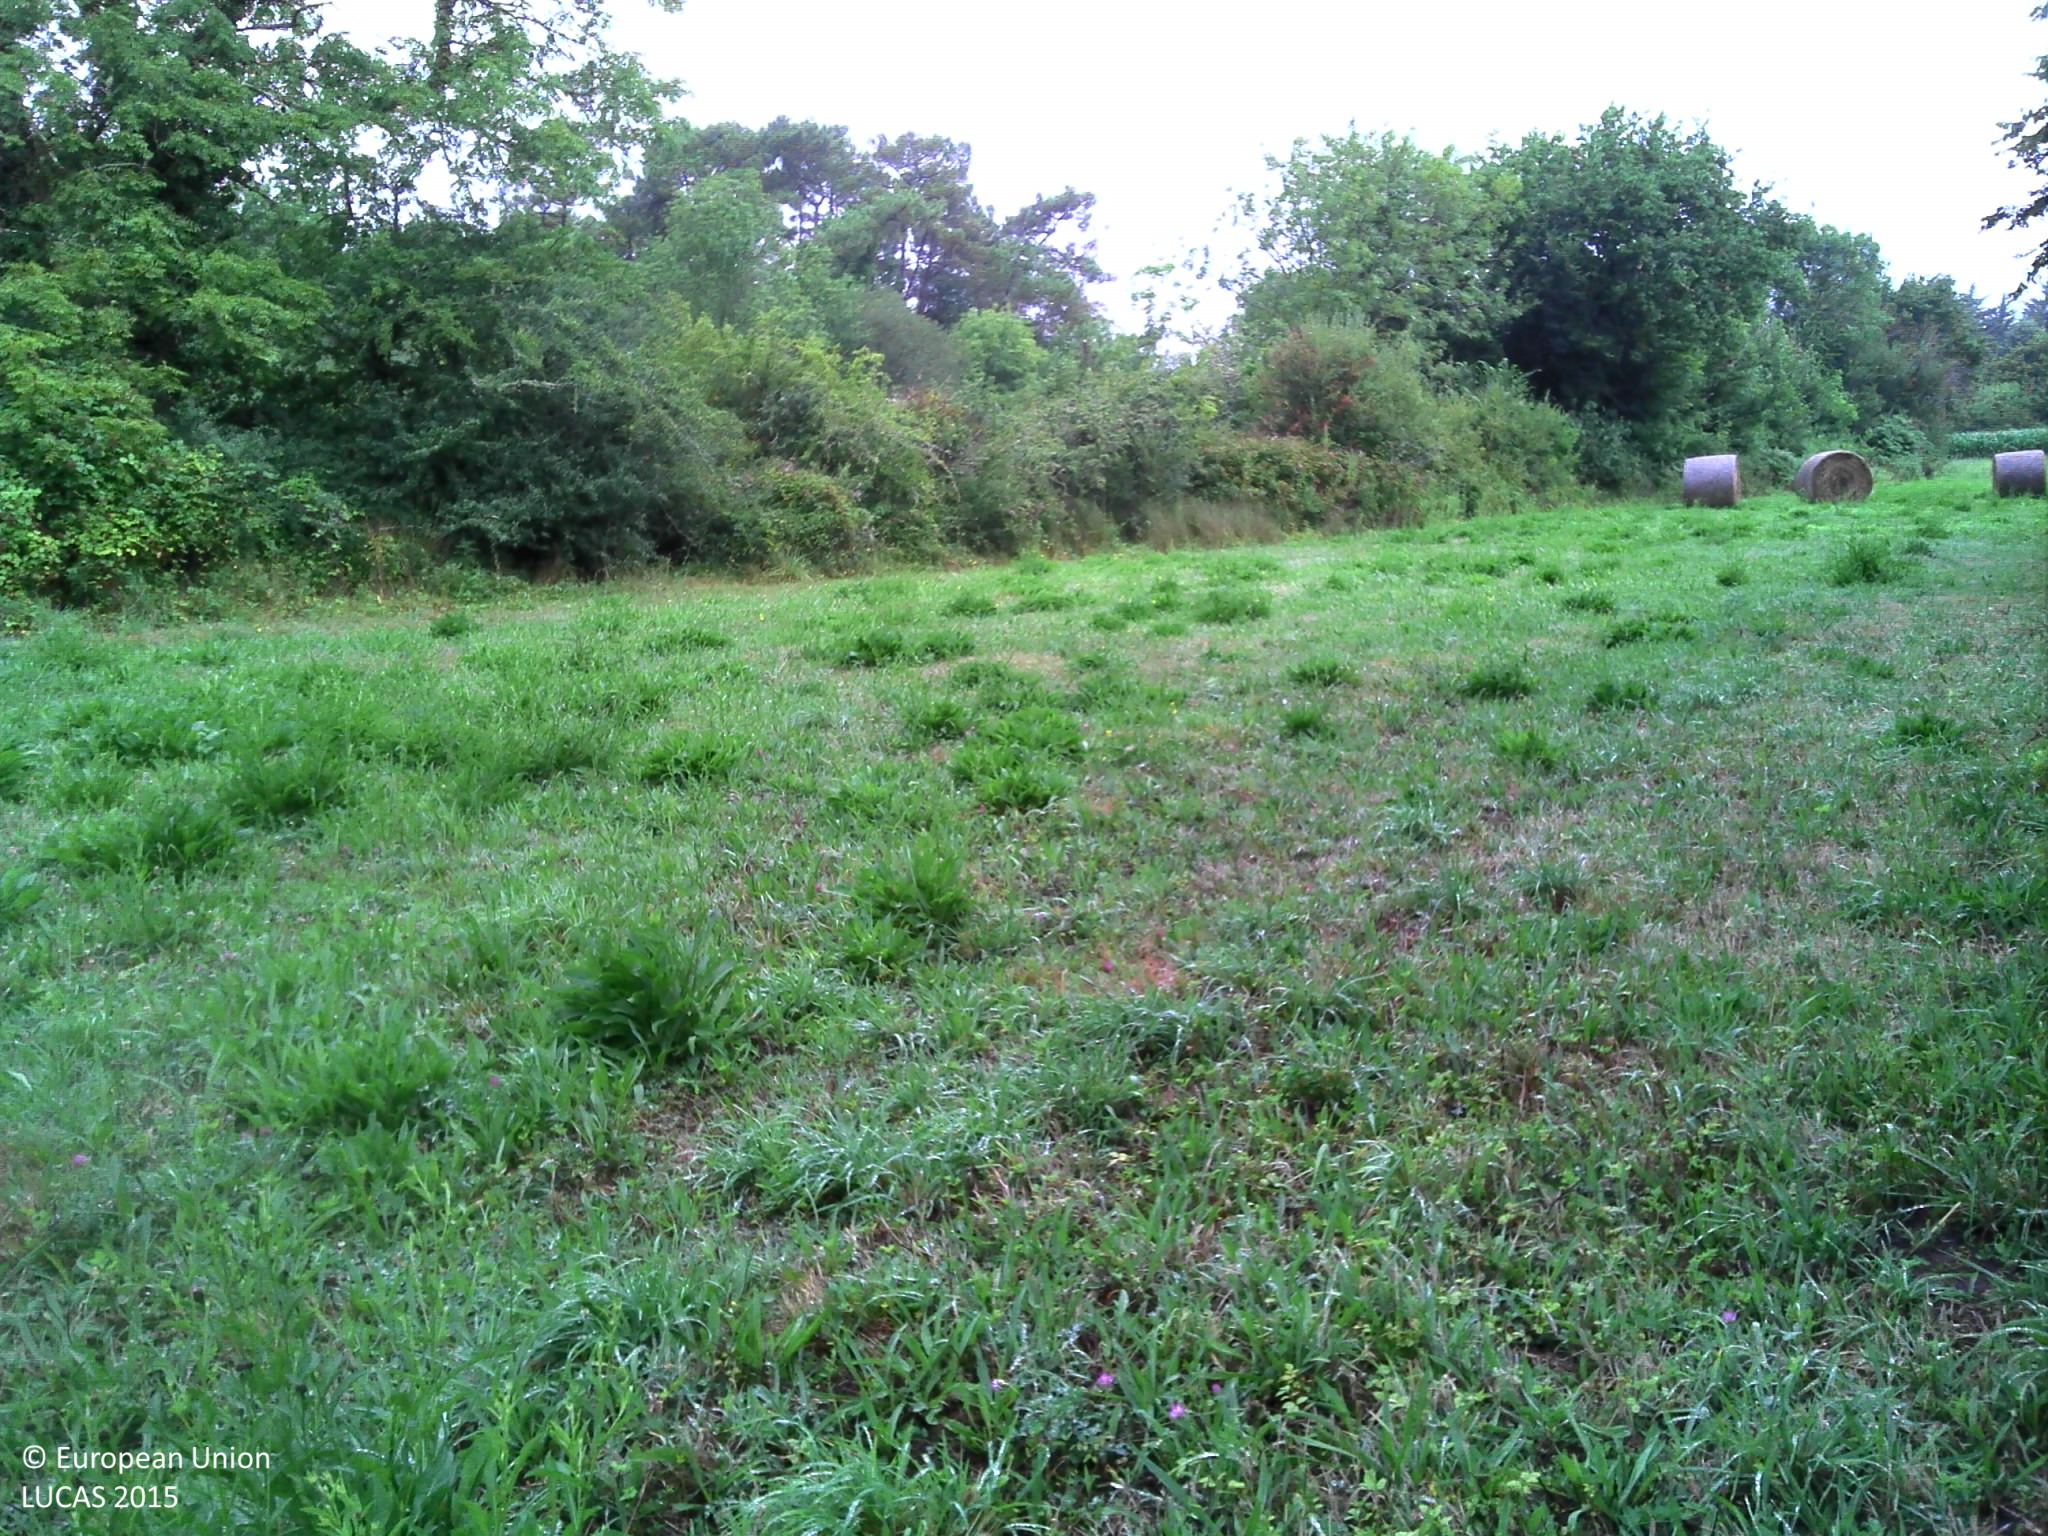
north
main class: Grassland
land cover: Grassland without tree/shrub cover
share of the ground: > 75 %
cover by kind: herbaceous plants 80 %, consolidated bare surface 20 %
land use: Agriculture (excluding fallow land and kitchen gardens)
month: July
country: FR
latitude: 47.6321
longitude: -3.1506
